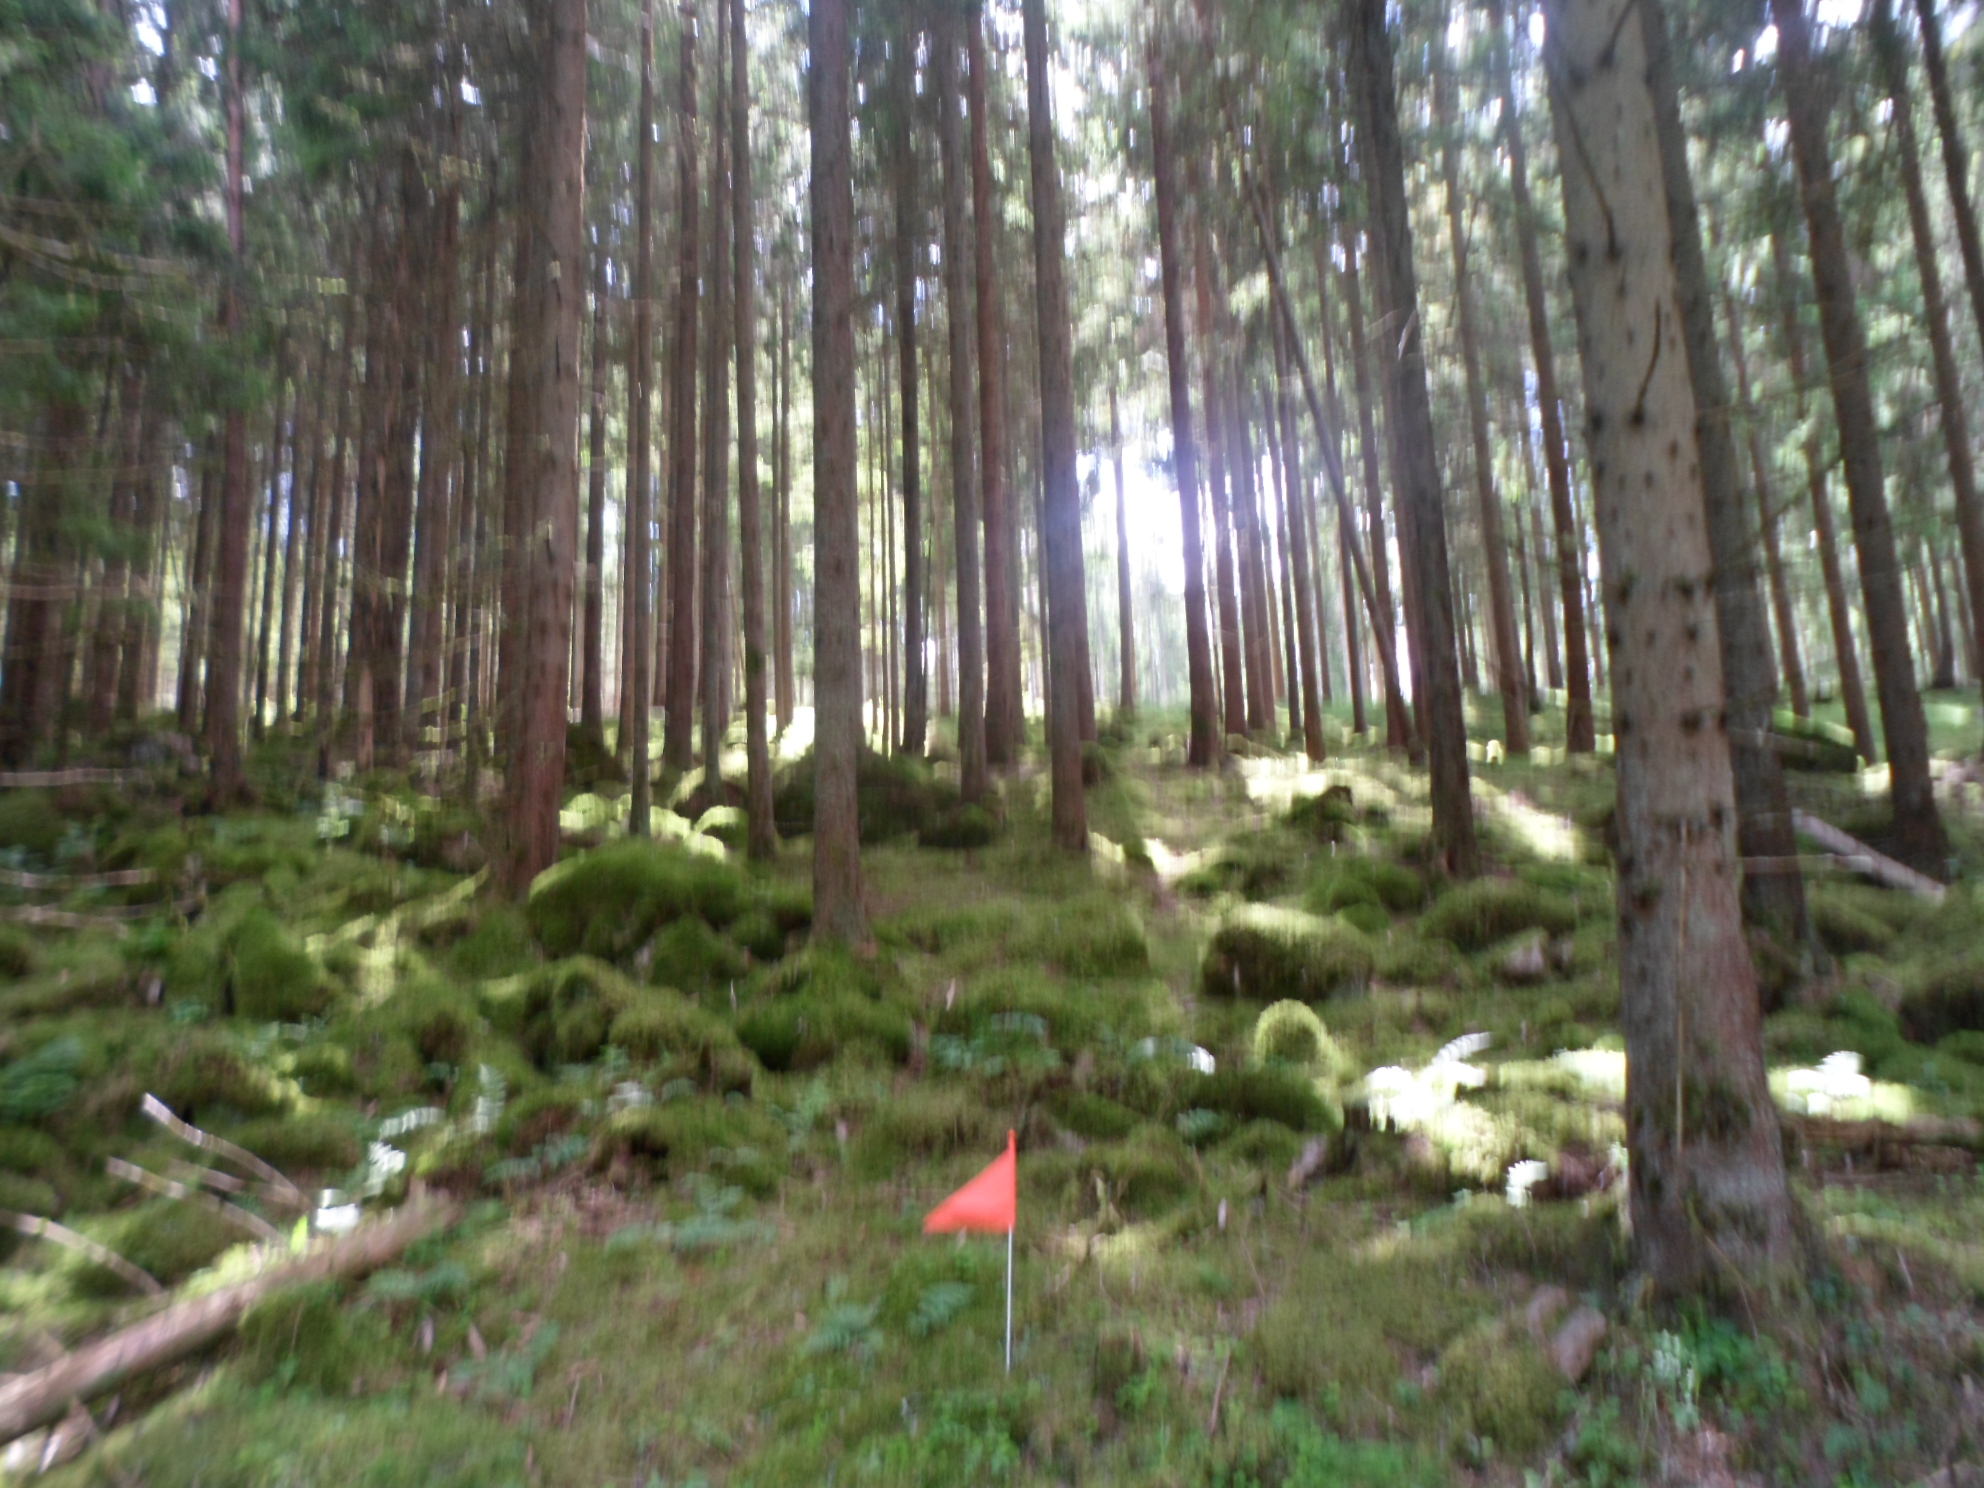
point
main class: Woodland
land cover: Spruce dominated coniferous woodland
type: boreal forest
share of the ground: > 75 %
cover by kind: coniferous forest trees 75 %, lichens and mosses 15 %, shrubs 5 %, herbaceous plants 5 %
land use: Forestry
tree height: > 5 m
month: June
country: SE
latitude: 57.1438
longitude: 14.7728
